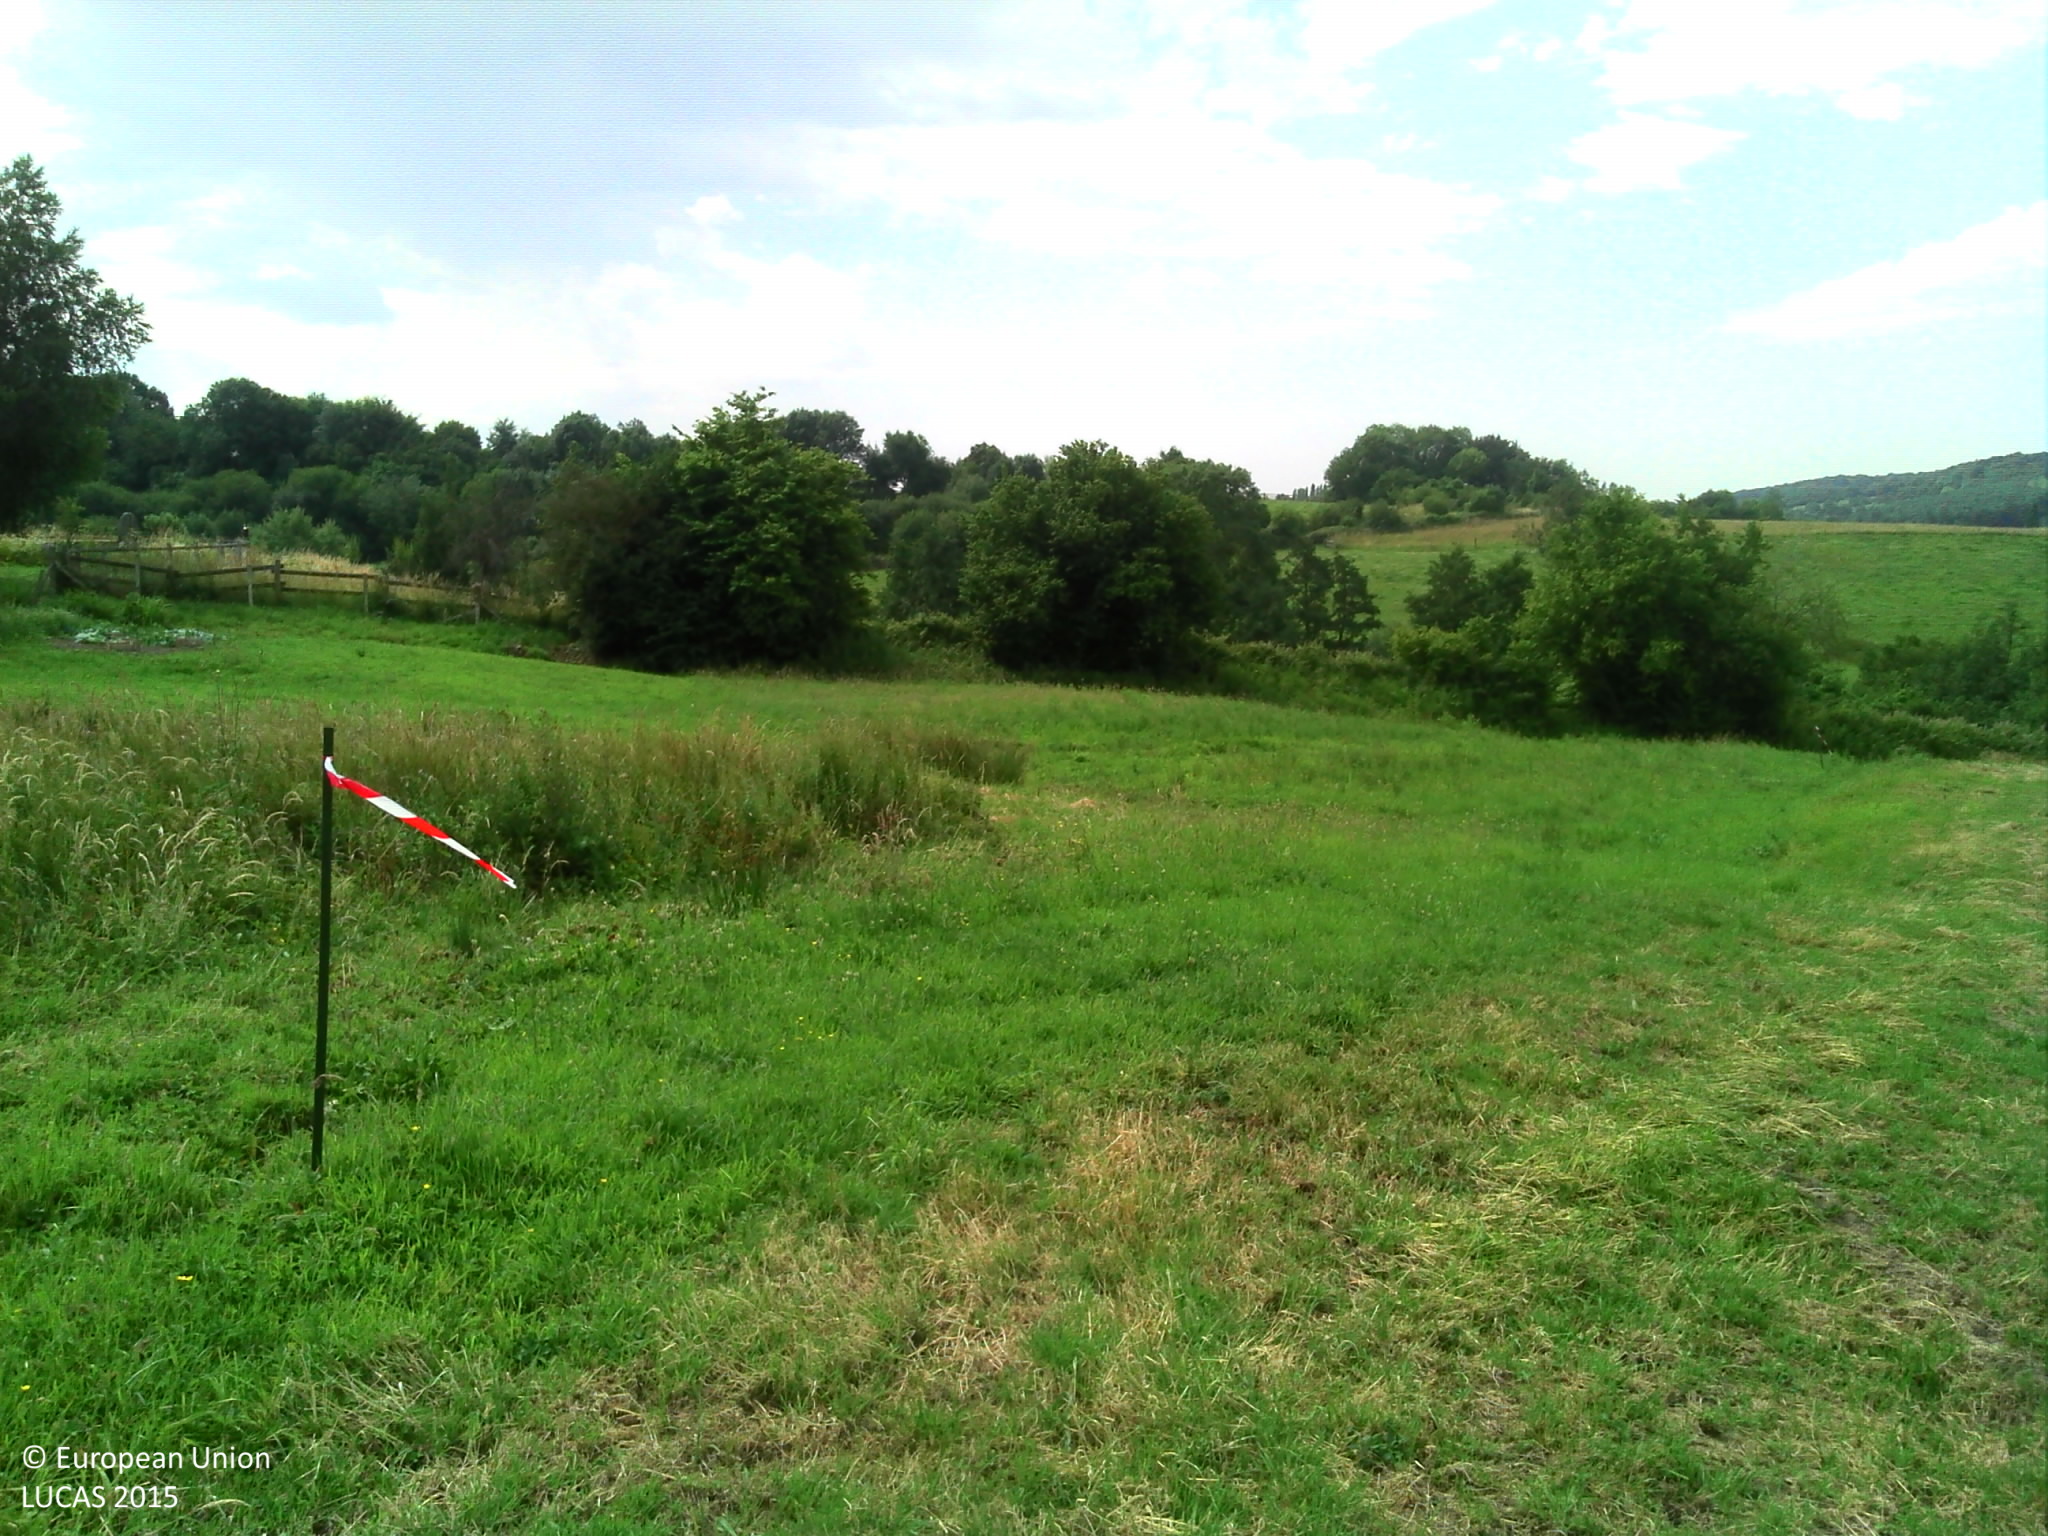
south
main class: Grassland
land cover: Grassland without tree/shrub cover
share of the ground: > 75 %
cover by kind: herbaceous plants 100 %
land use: Agriculture (excluding fallow land and kitchen gardens)
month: July
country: FR
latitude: 49.0259
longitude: 0.0823
